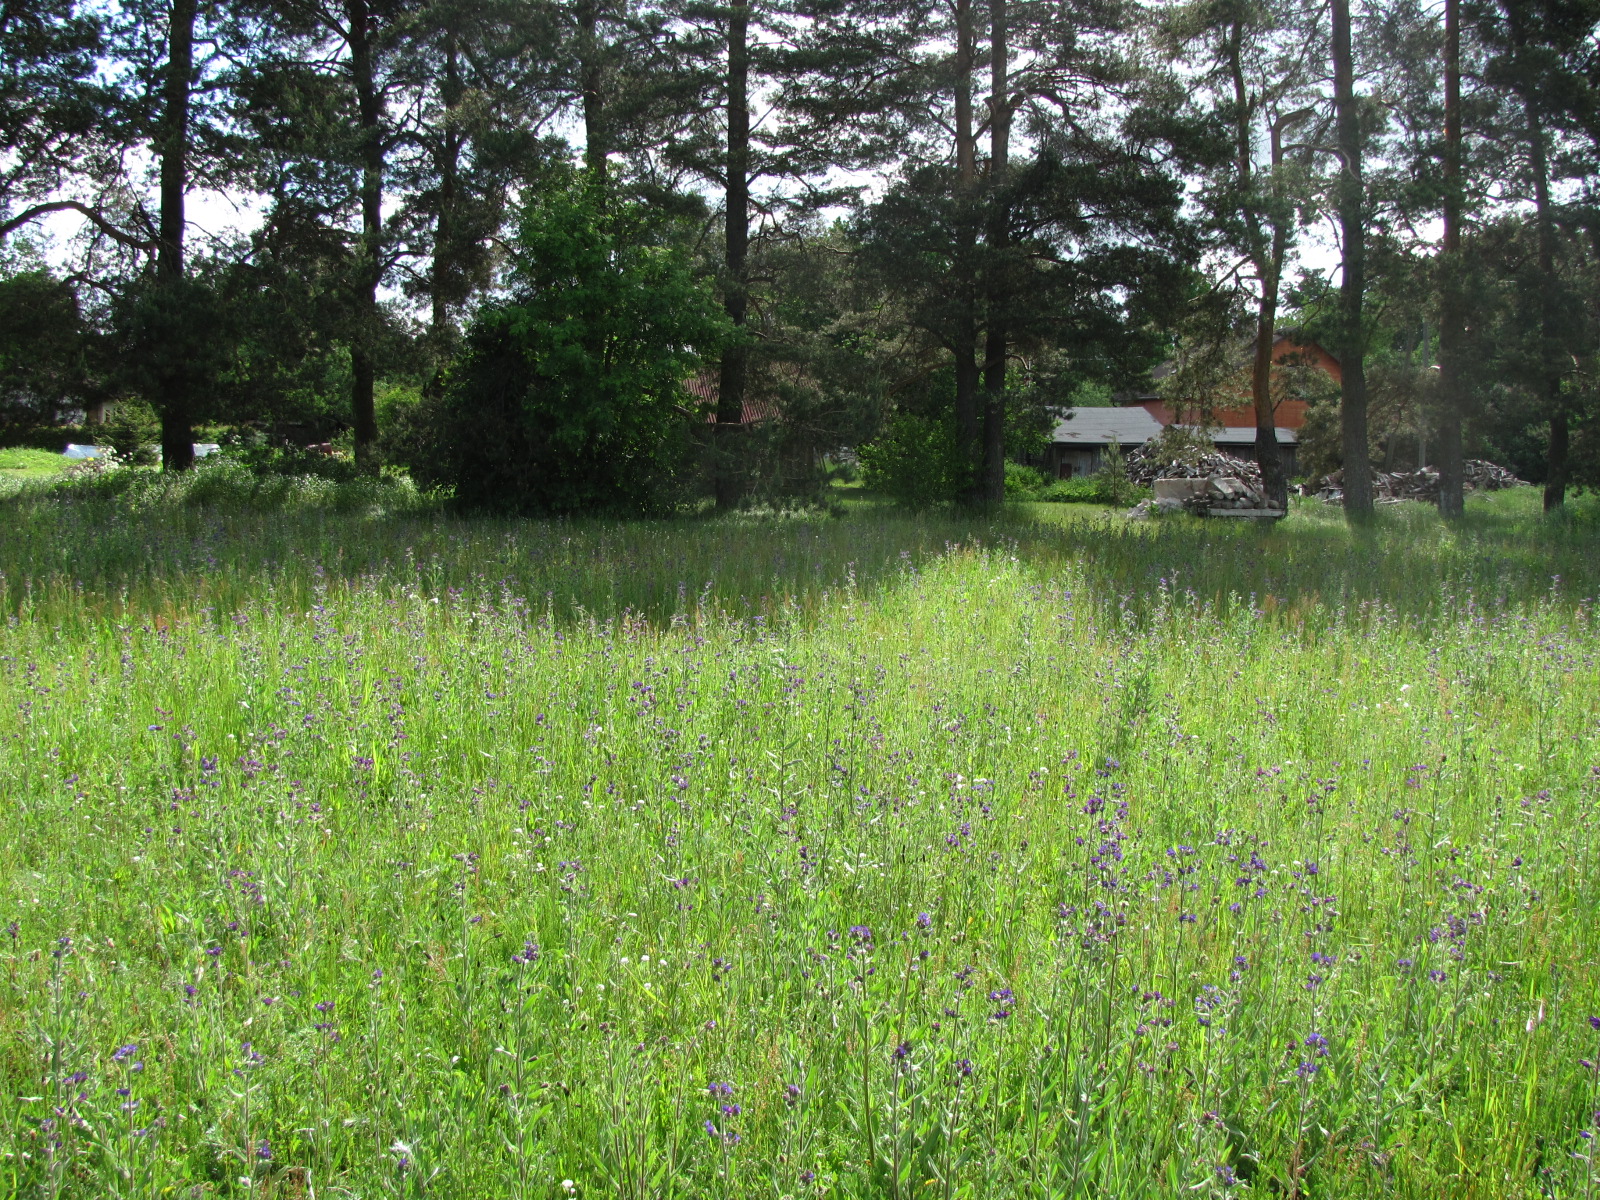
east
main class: Grassland
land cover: Grassland without tree/shrub cover
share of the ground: > 75 %
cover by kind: herbaceous plants 100 %
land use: Residential
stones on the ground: < 10 %
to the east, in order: Grassland without tree/shrub cover; Lines of trees; Artificial constructions in urban areas; Grassland without tree/shrub cover; Lines of trees; Grassland without tree/shrub cover; Electric lines; Grassland without tree/shrub cover; Other fresh vegetables; Grassland without tree/shrub cover; Broadleaved woodland; Grassland with sparse tree/shrub cover
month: June
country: LV
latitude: 56.8193
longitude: 24.5289
